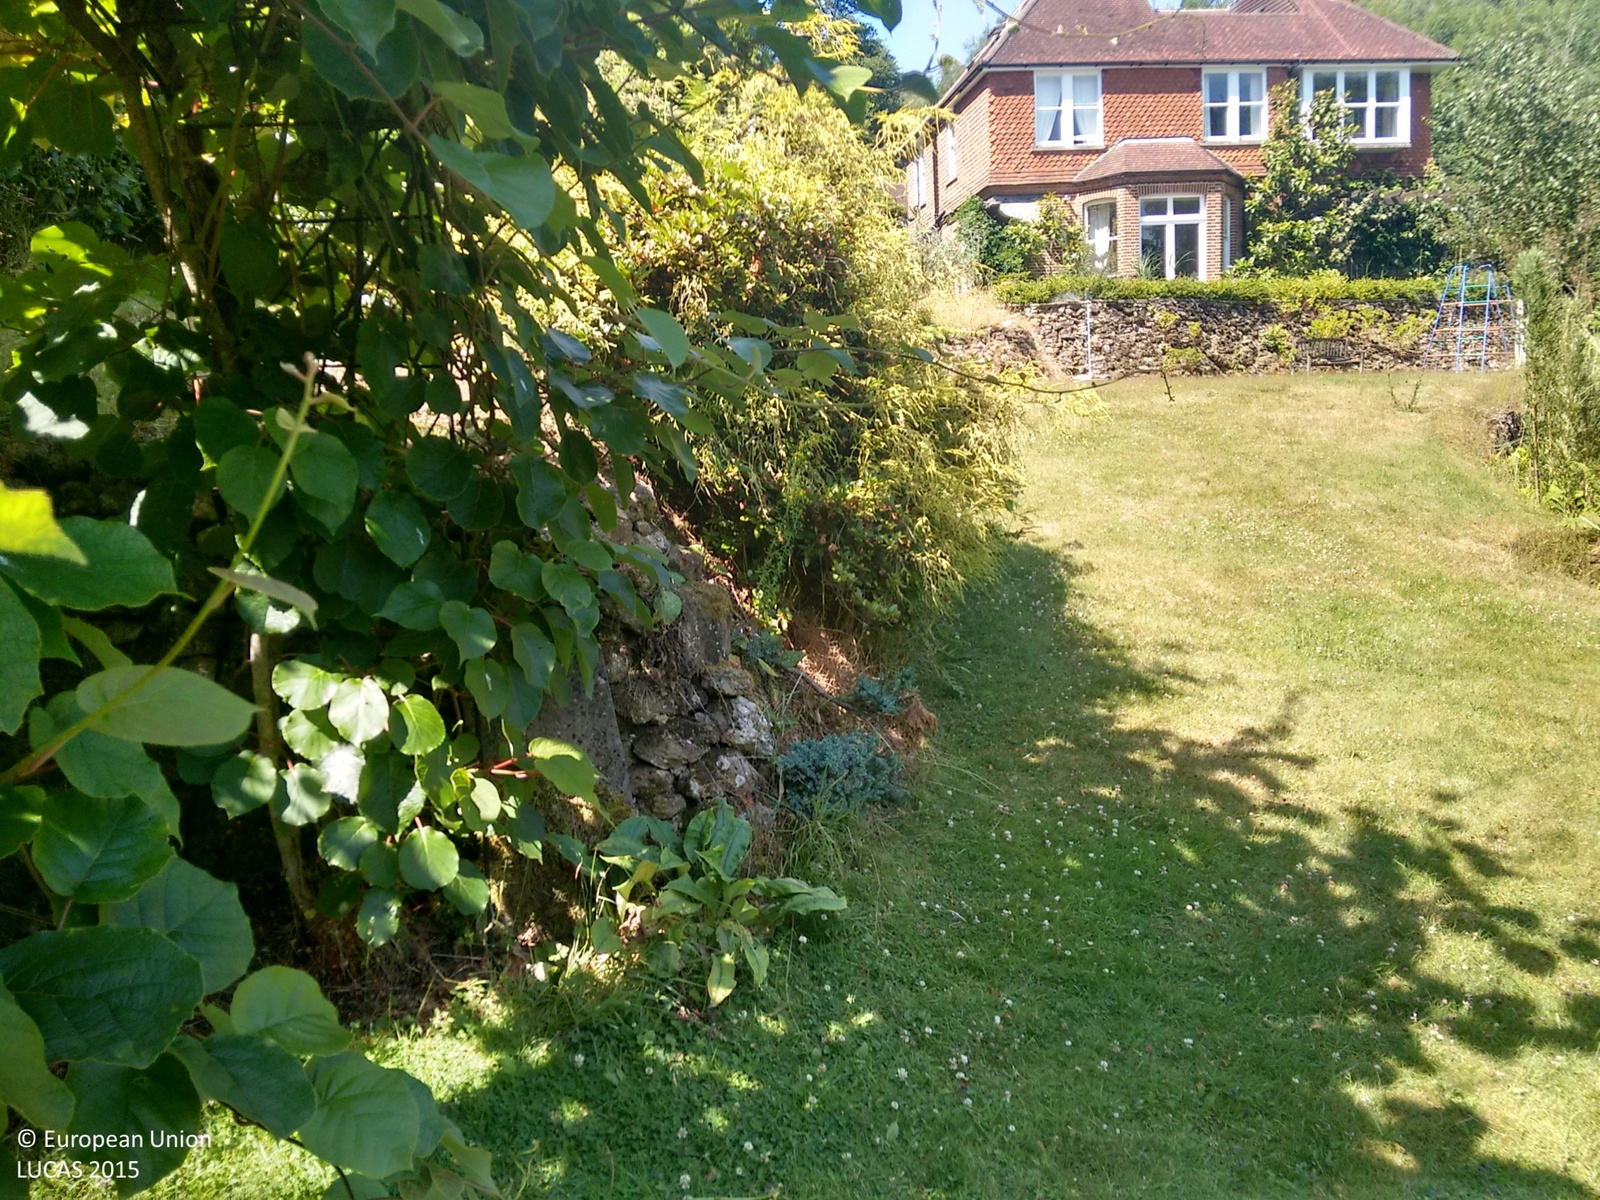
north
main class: Grassland
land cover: Grassland with sparse tree/shrub cover
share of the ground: > 75 %
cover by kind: herbaceous plants 95 %, broadleaved forest trees 5 %
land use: Residential
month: July
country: GB
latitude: 51.1702
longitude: -0.4643
